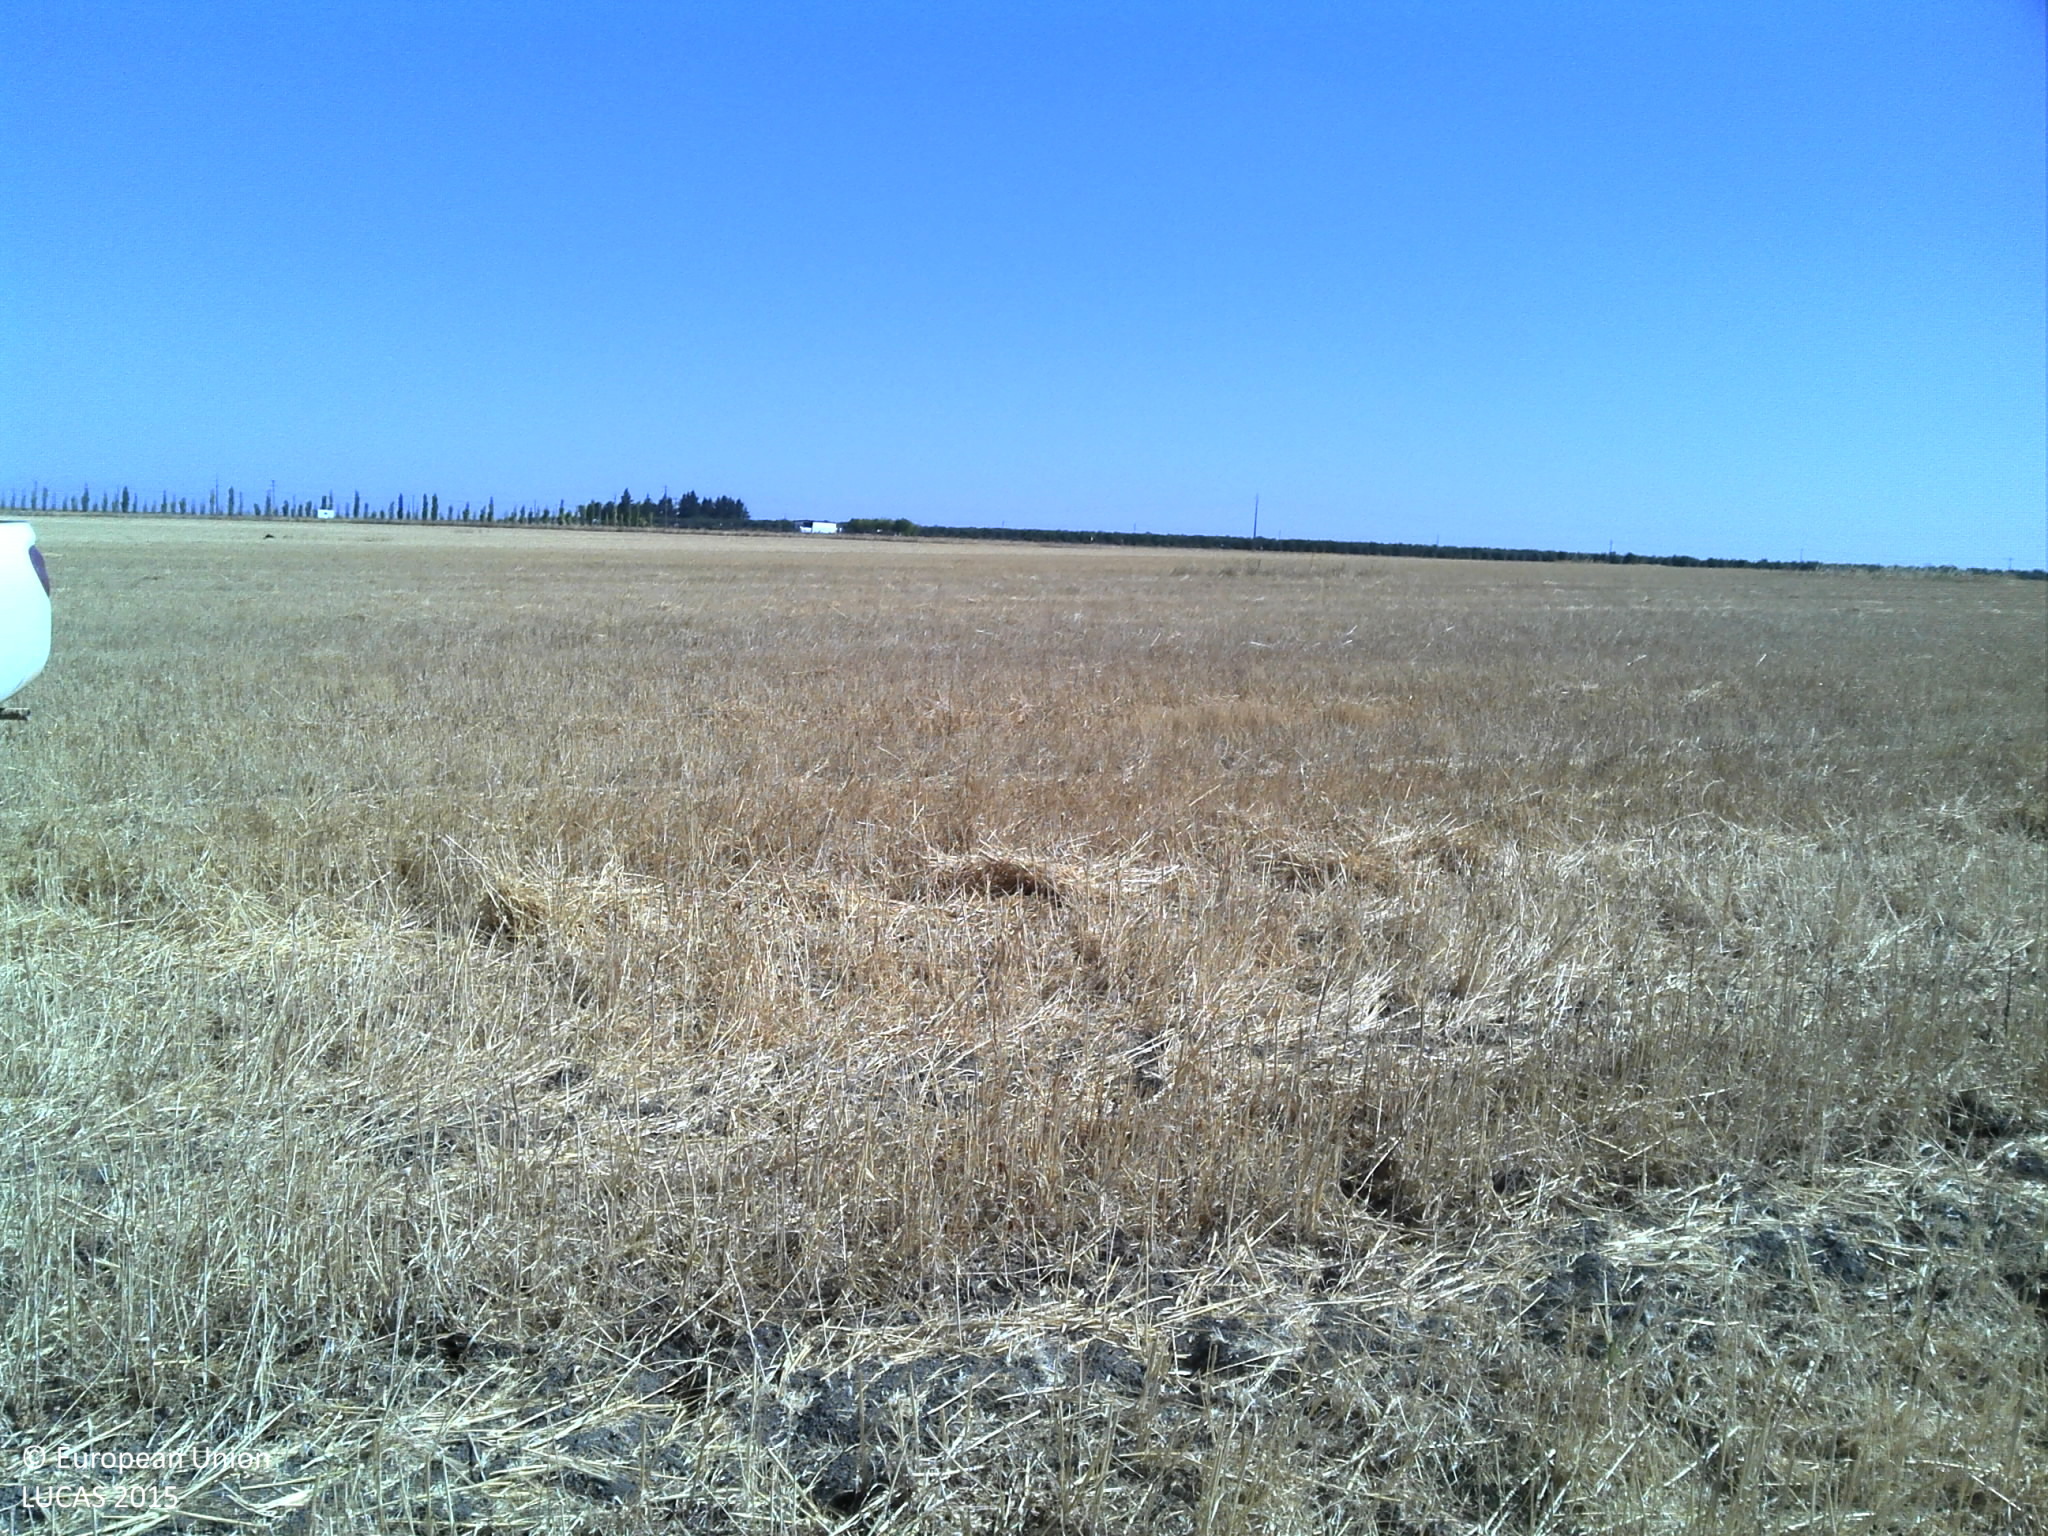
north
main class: Cropland
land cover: Common wheat
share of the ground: > 75 %
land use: Agriculture (excluding fallow land and kitchen gardens)
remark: Harvested field
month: August
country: PT
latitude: 37.9876
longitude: -7.8459
